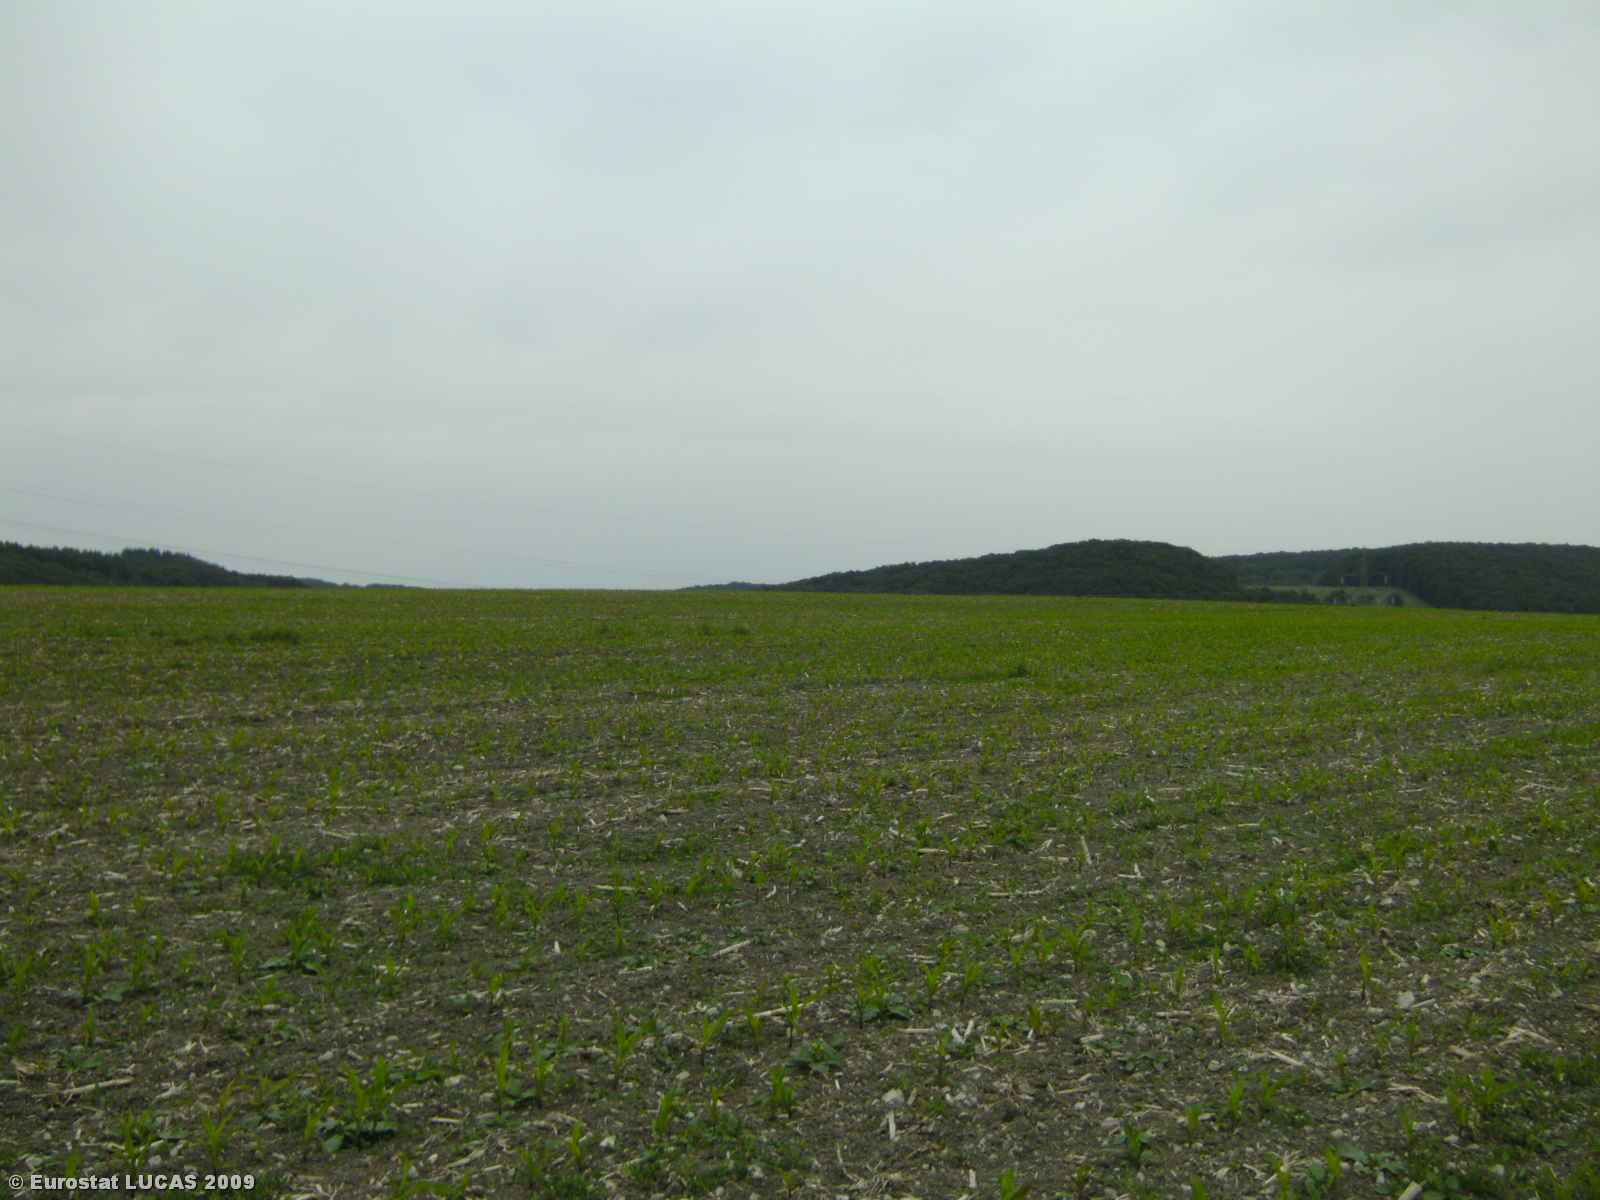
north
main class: Cropland
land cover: Maize
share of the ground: 10 - 25 %
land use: Agriculture (excluding fallow land and kitchen gardens)
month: June
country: LU
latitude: 49.7271
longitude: 6.2678
